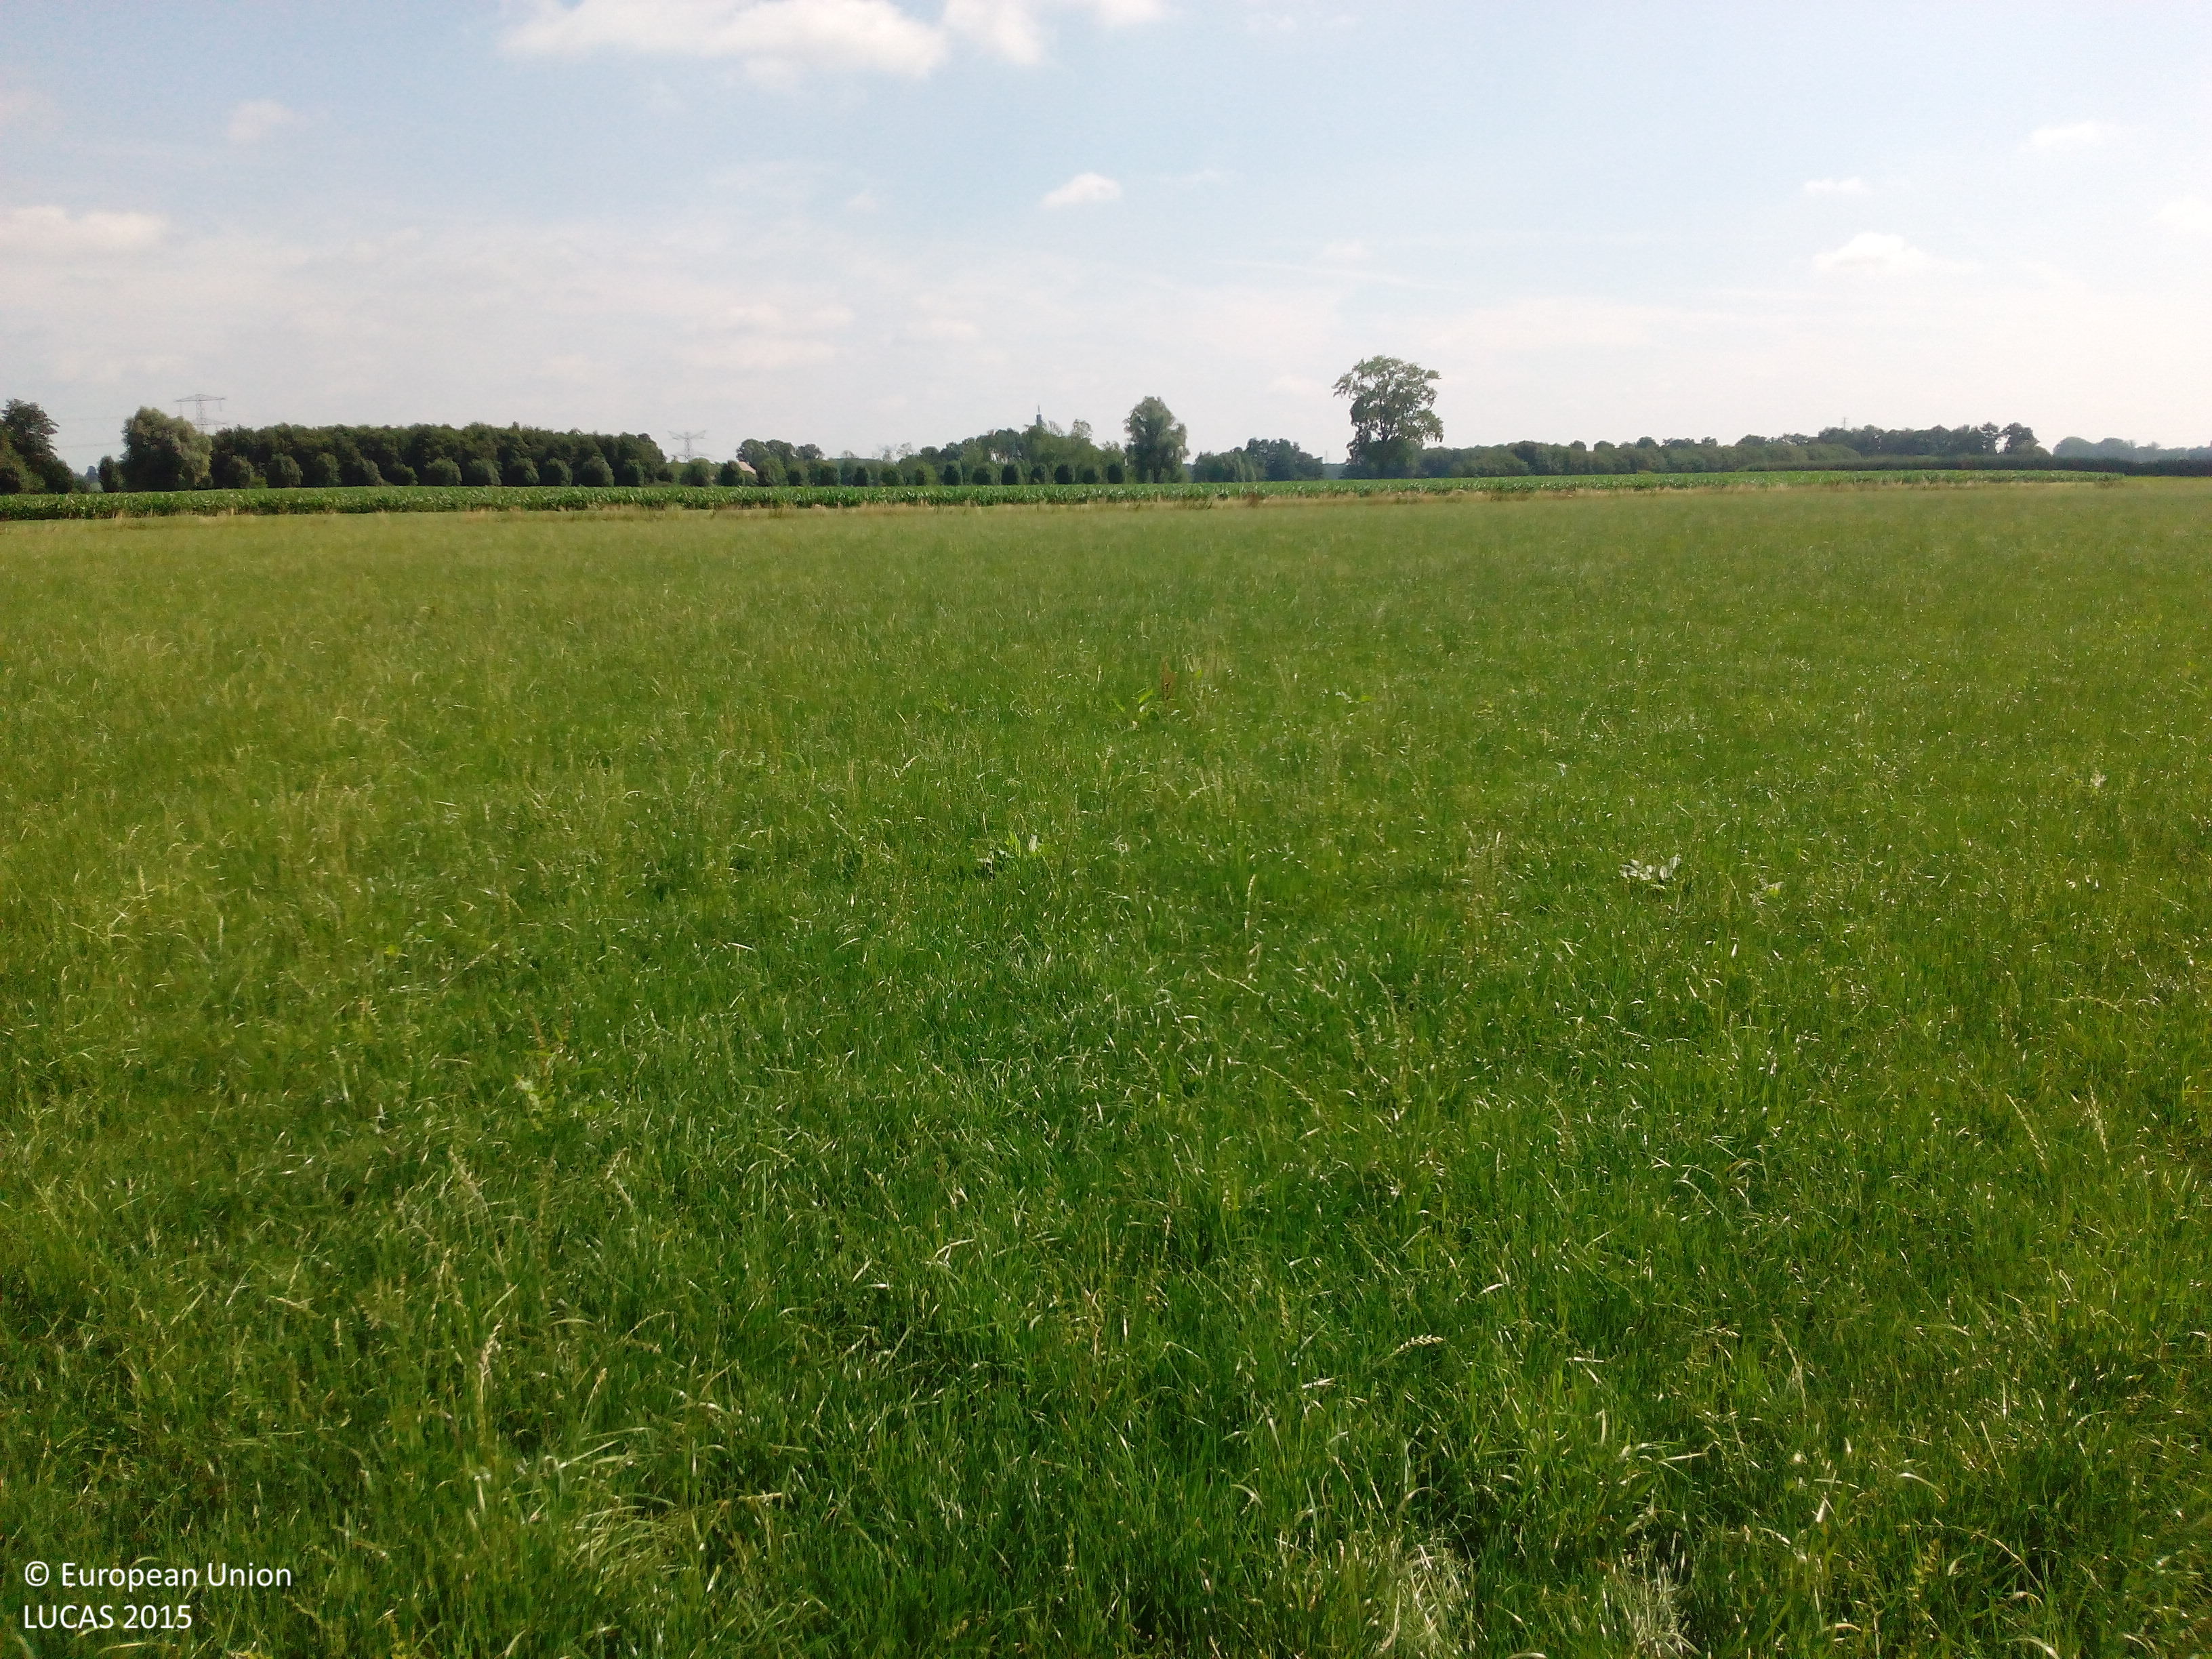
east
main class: Grassland
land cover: Grassland without tree/shrub cover
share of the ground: > 75 %
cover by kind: herbaceous plants 100 %
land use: Agriculture (excluding fallow land and kitchen gardens)
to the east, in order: Grassland without tree/shrub cover; Inland fresh running water; Grassland without tree/shrub cover; Maize
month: July
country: NL
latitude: 51.9757
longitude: 6.2289
